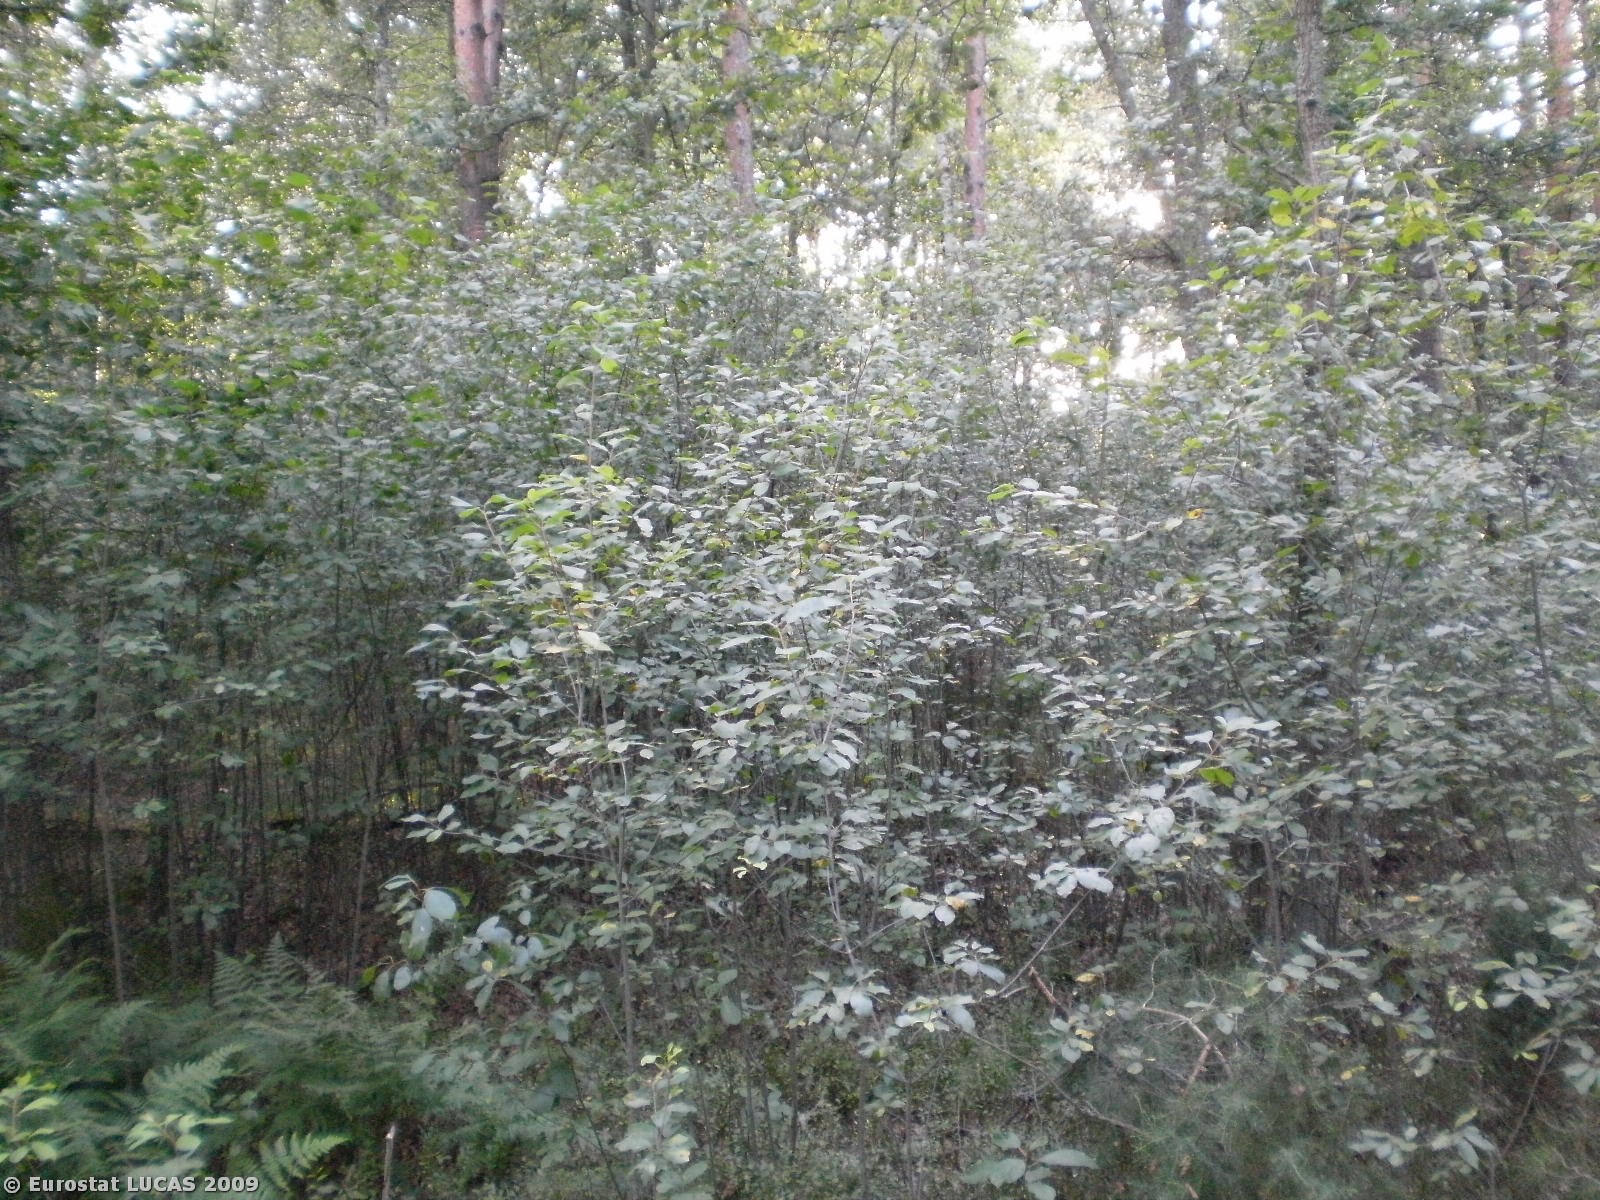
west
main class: Woodland
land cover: Mixed woodland
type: hemiboreal forest and nemoral coniferous forest and mixed broadleaved-coniferous forest
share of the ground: > 75 %
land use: Forestry
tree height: > 5 m
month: August
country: PL
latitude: 52.5783
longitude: 21.6970
